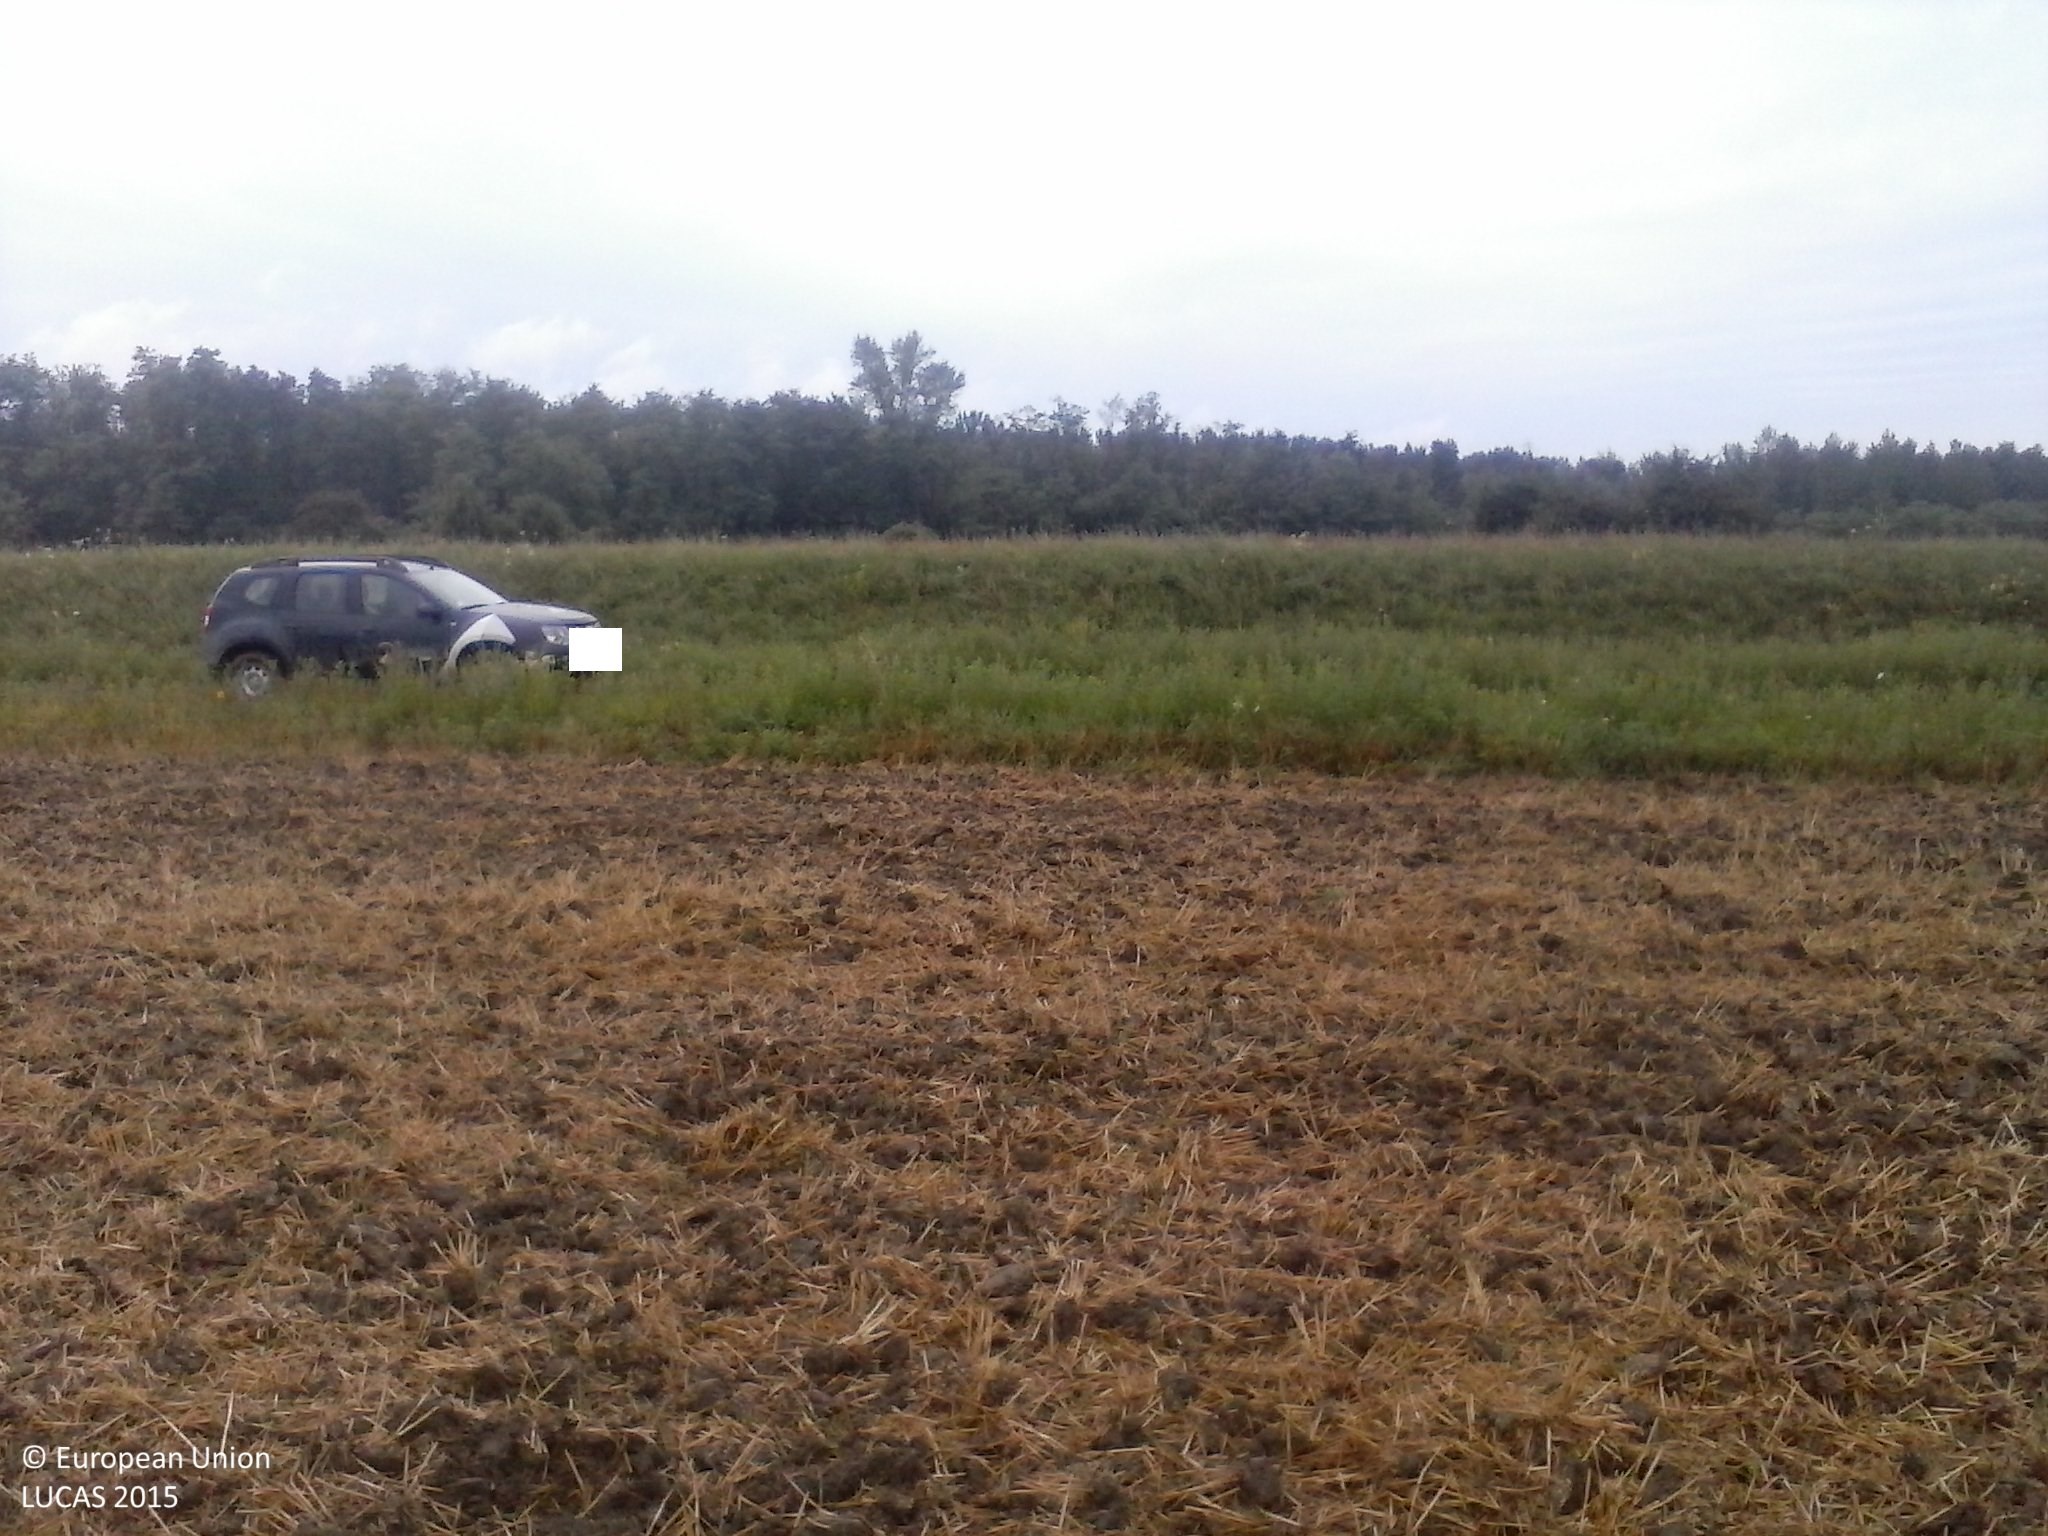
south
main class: Cropland
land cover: Common wheat
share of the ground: 50 - 75 %
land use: Agriculture (excluding fallow land and kitchen gardens)
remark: Harvested field
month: July
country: HU
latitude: 45.9161
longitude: 17.6233
